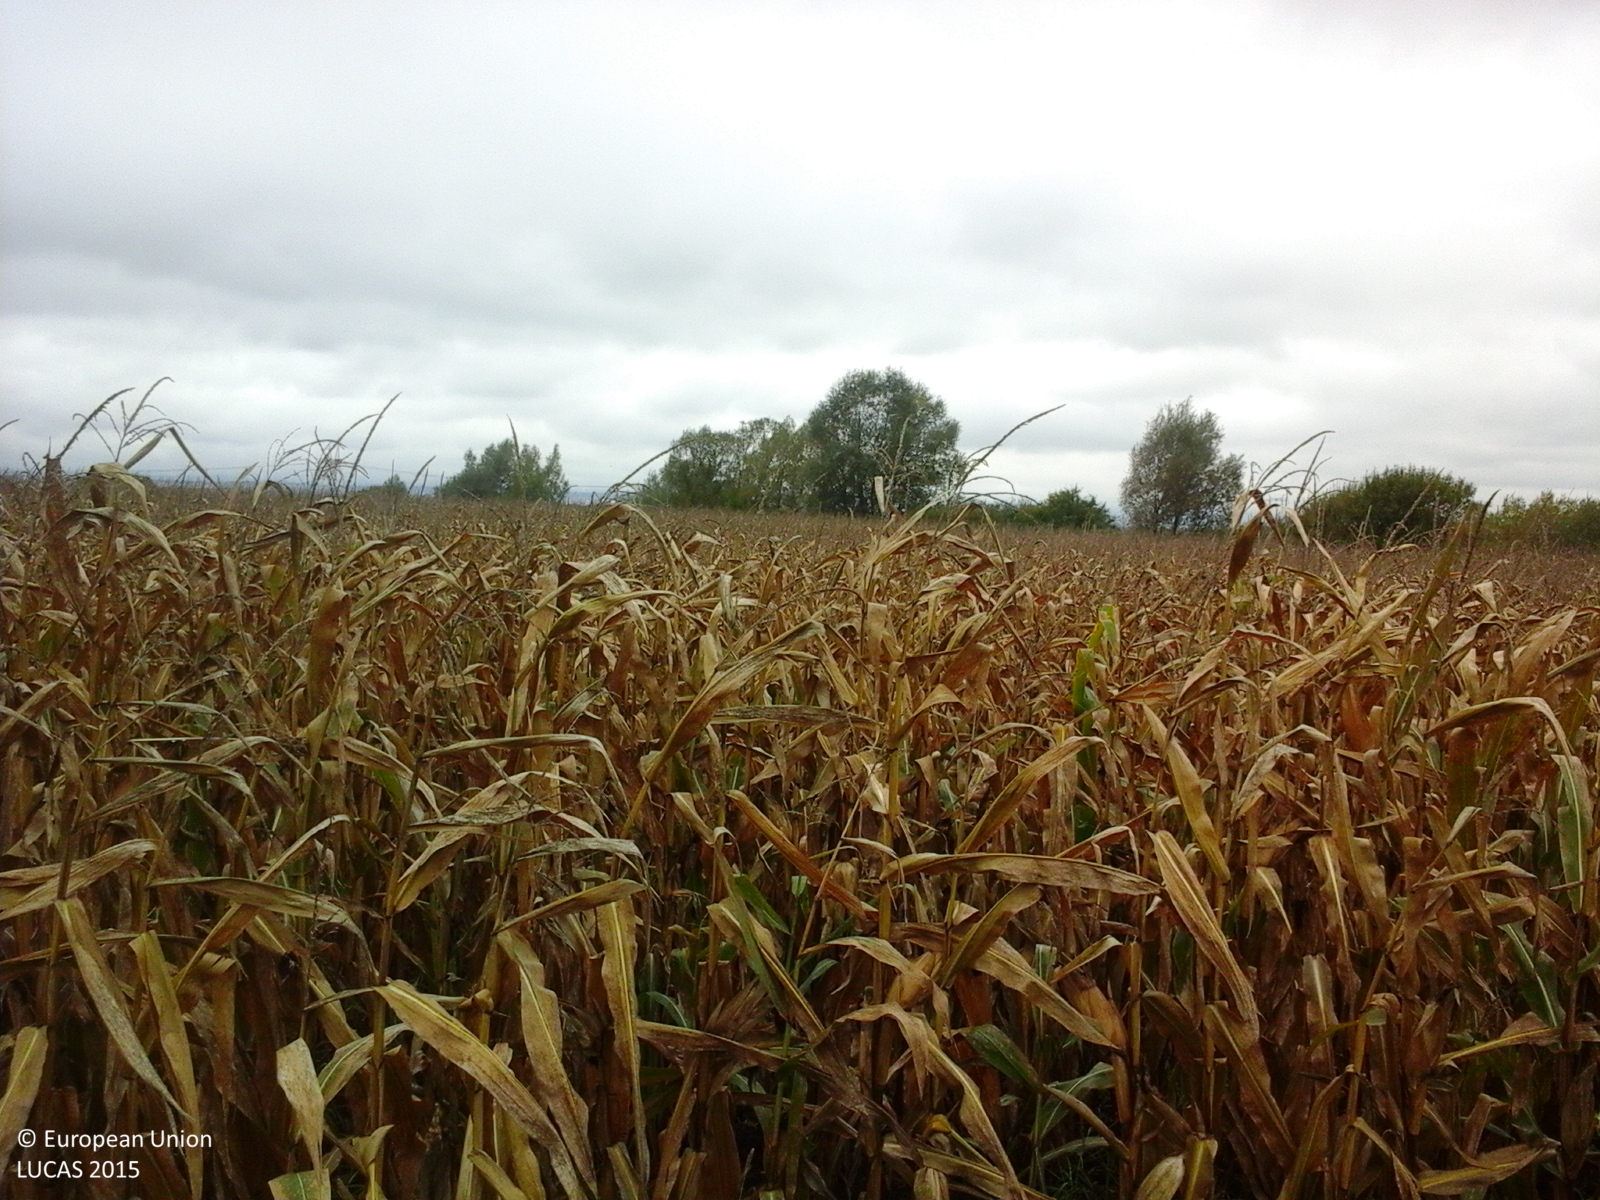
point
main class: Cropland
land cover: Maize
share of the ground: > 75 %
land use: Agriculture (excluding fallow land and kitchen gardens)
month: October
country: RO
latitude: 45.8293
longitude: 24.1188
